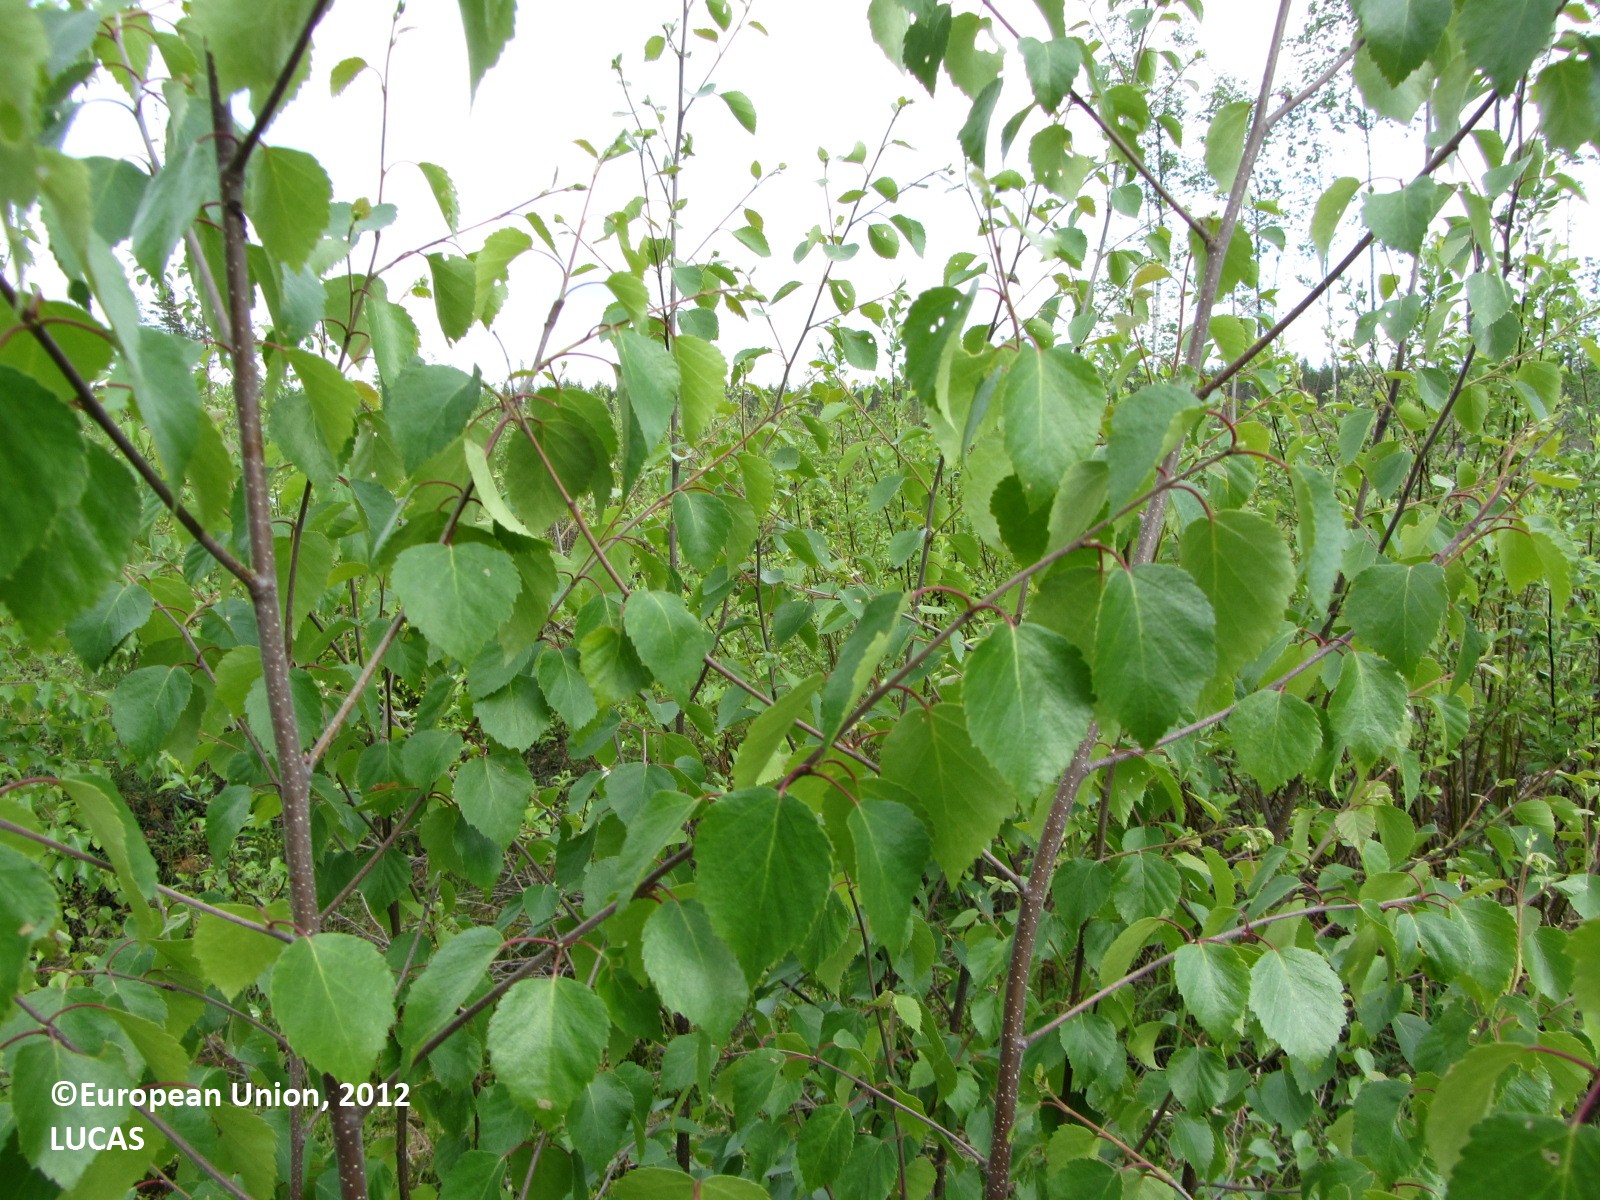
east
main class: Woodland
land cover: Broadleaved woodland
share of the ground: 25 - 50 %
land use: Energy production
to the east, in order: Broadleaved woodland; Electric lines; Broadleaved woodland; Tracks; Shrubland with sparse tree cover; Rocks and stones; Shrubland with sparse tree cover; Ditches and canals; Managed hedges; Grass margins; Paved roads, cycling and walking lanes; Grass margins; Abandoned hedges; Shrubland with sparse tree cover; Other mixed woodland; Pine dominated mixed woodland
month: June
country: FI
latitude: 62.2768
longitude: 25.1942
